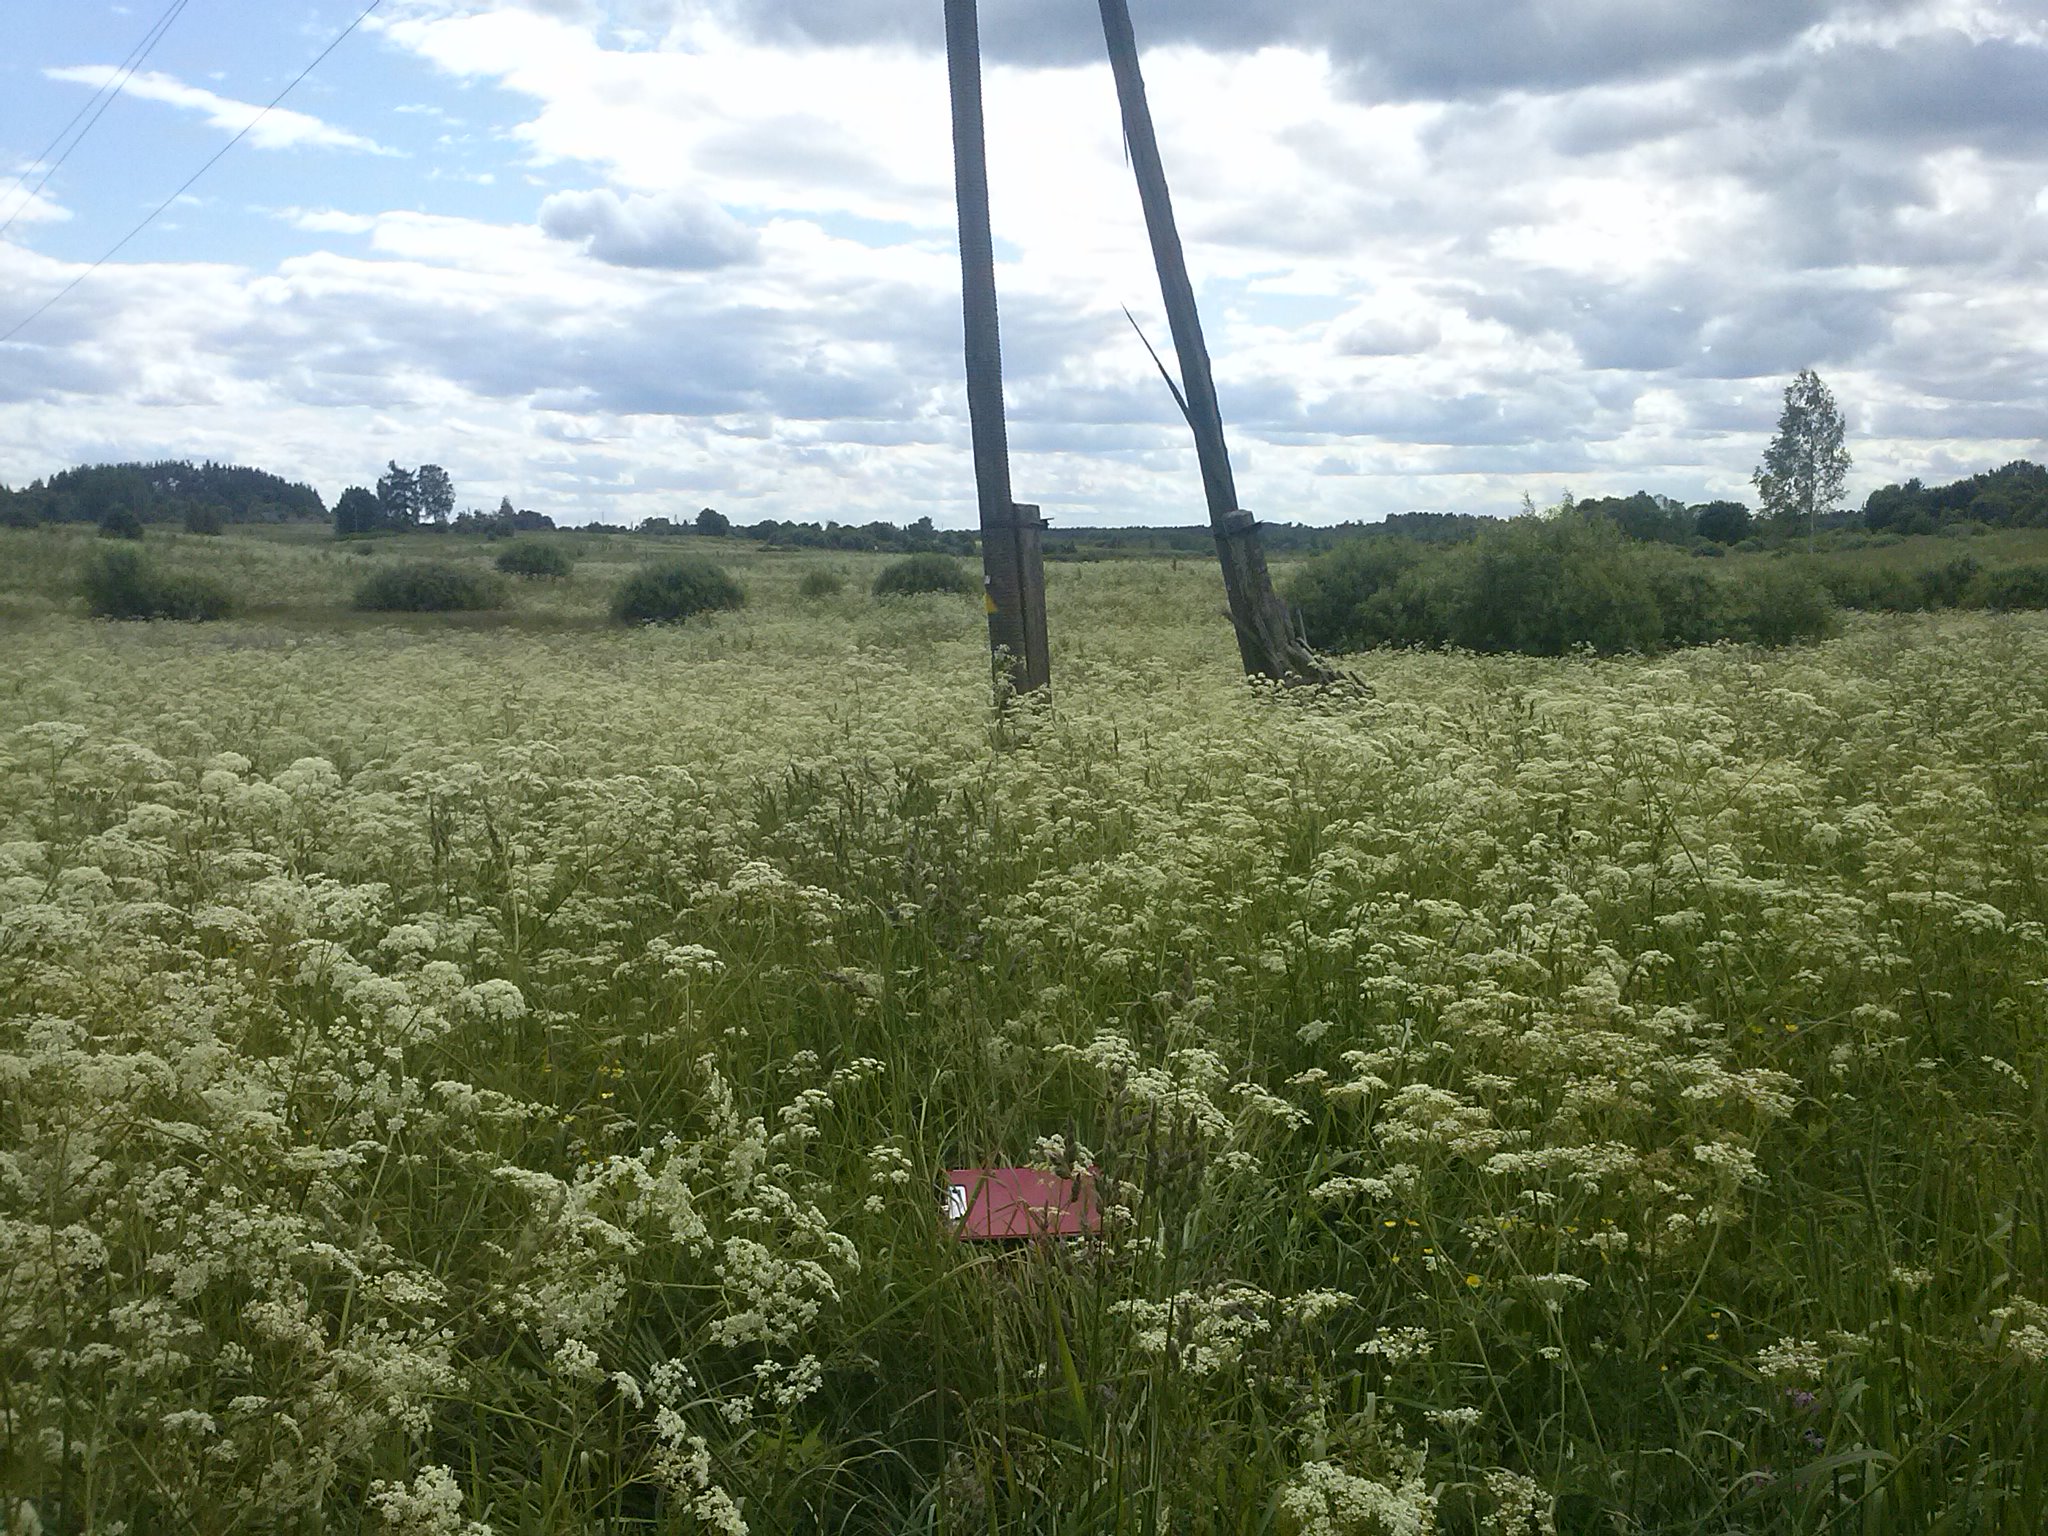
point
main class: Grassland
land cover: Spontaneously vegetated surfaces
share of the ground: > 75 %
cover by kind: herbaceous plants 100 %
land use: Semi-natural and natural areas not in use
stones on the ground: < 10 %
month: June
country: LV
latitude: 56.4224
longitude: 27.6786
